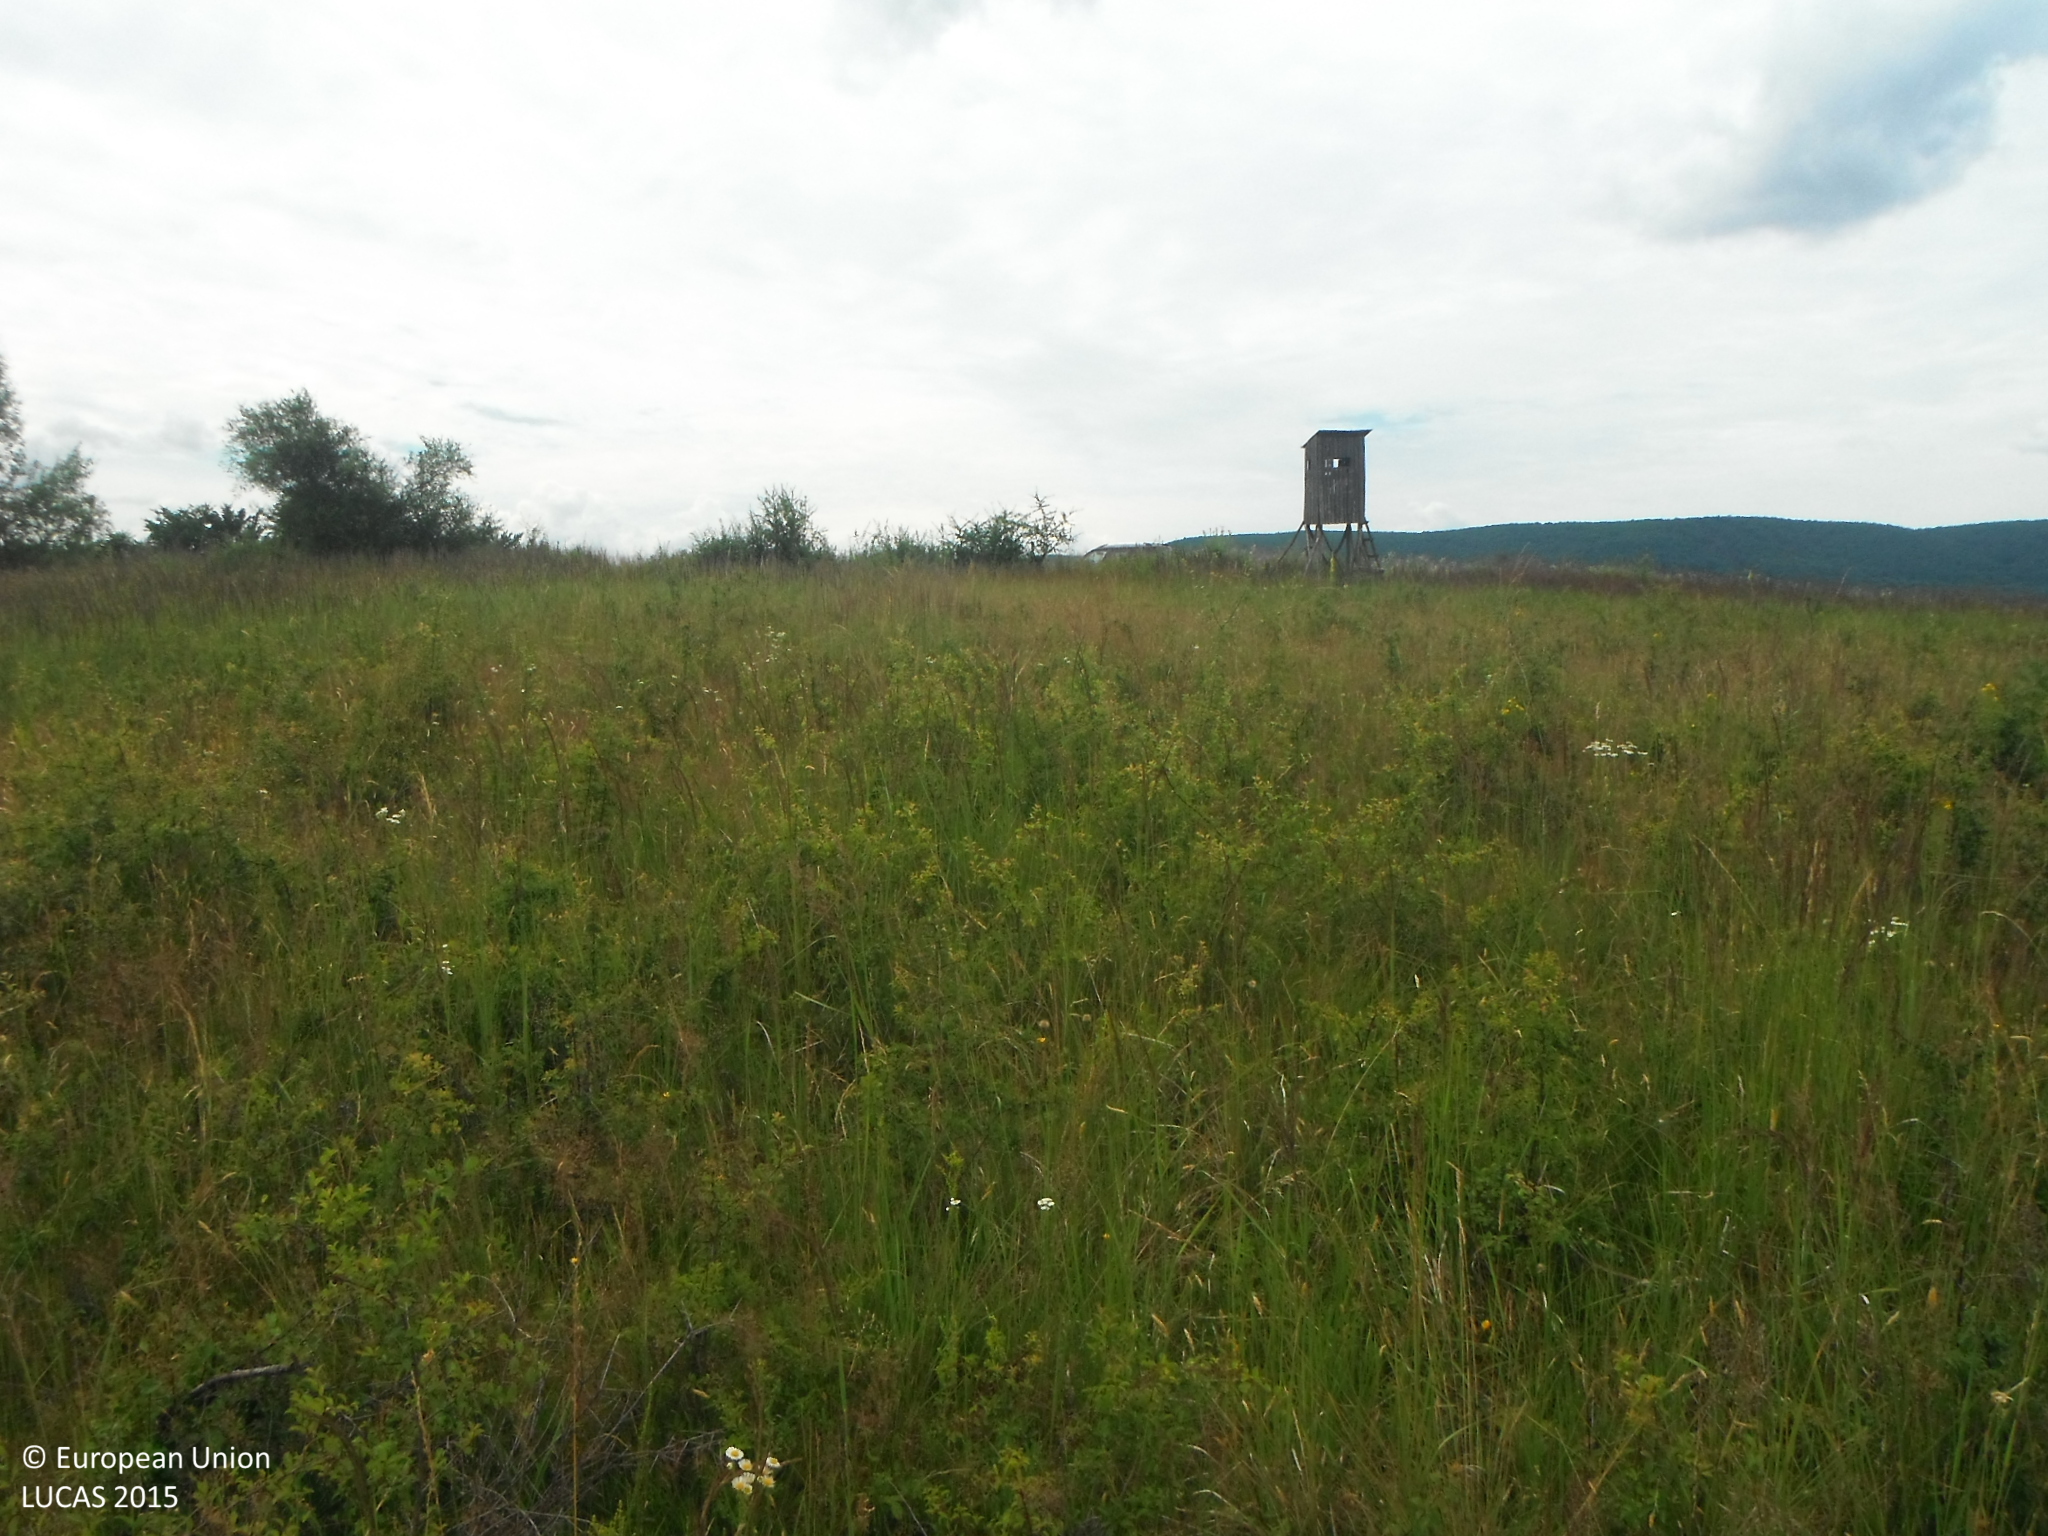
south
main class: Grassland
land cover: Grassland with sparse tree/shrub cover
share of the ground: > 75 %
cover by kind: herbaceous plants 90 %, broadleaved forest trees 5 %, shrubs 5 %
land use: Semi-natural and natural areas not in use
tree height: < 5 m
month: June
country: SK
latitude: 48.5086
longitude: 20.2245
